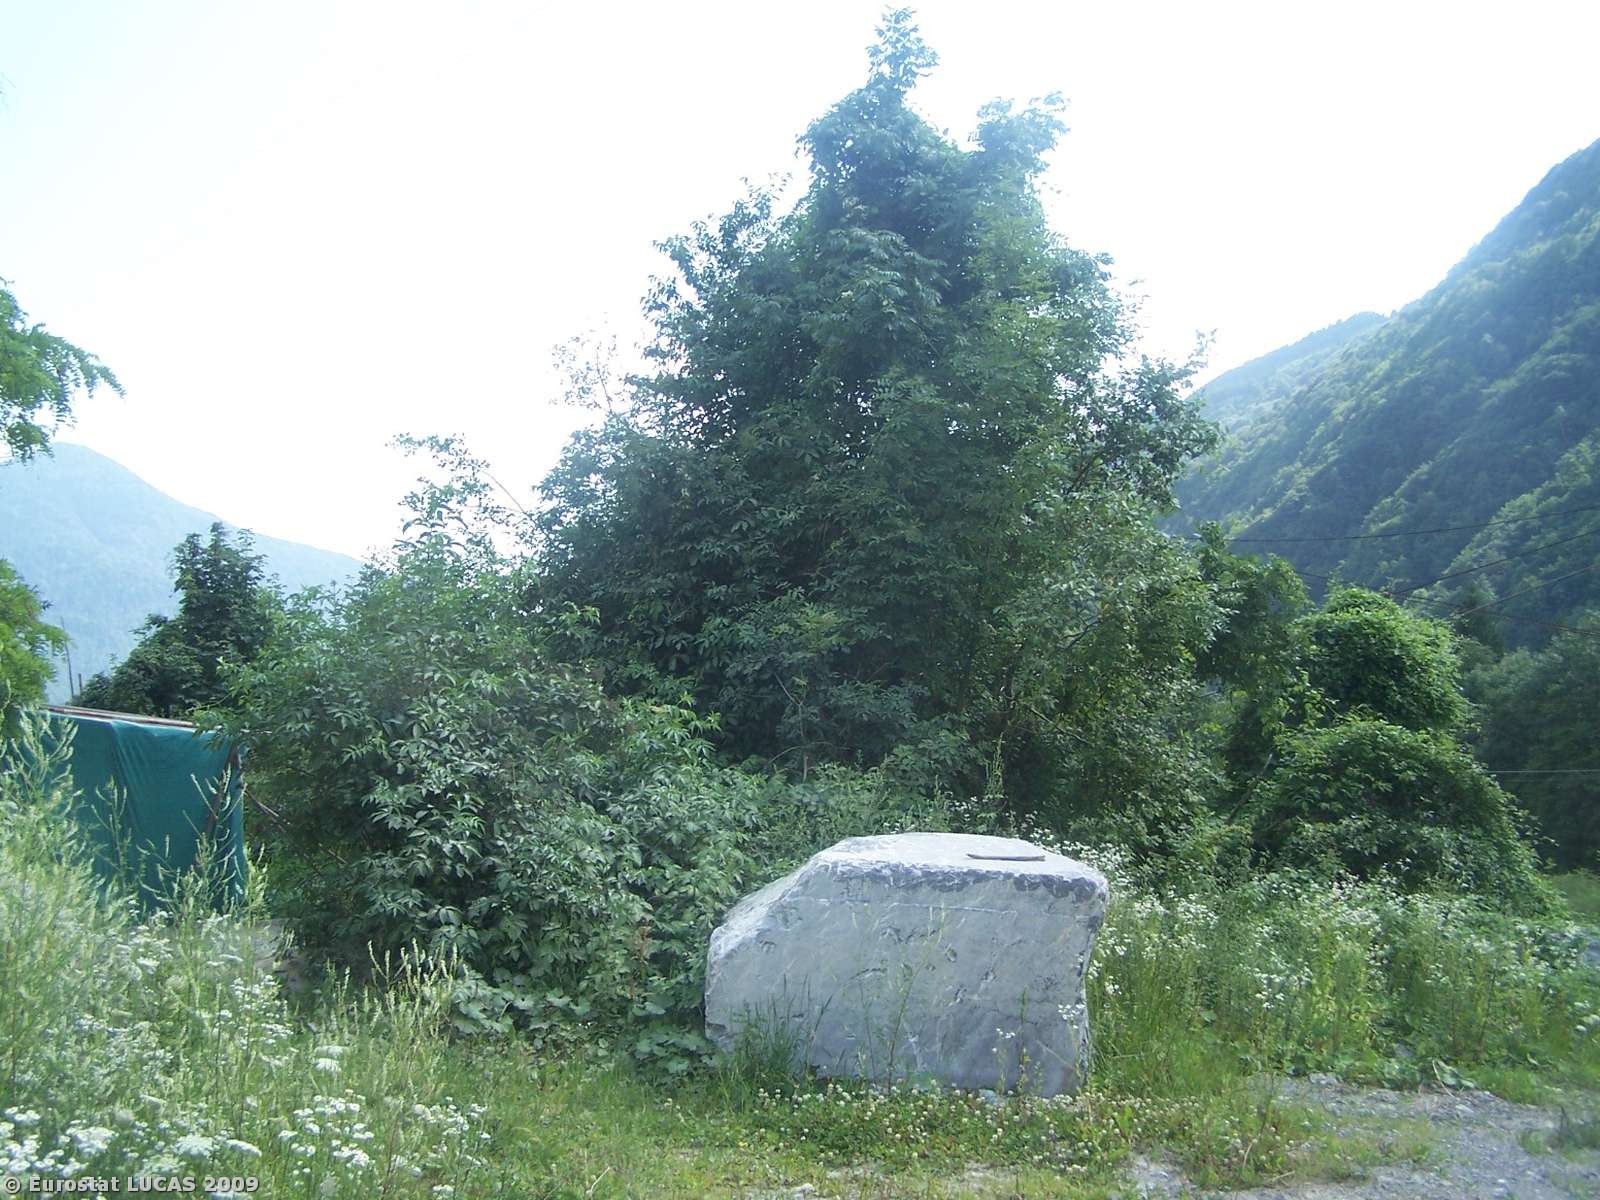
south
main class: Grassland
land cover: Spontaneously vegetated surfaces
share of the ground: 50 - 75 %
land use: Mining and quarrying
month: July
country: IT
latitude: 46.5612
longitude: 13.0105
